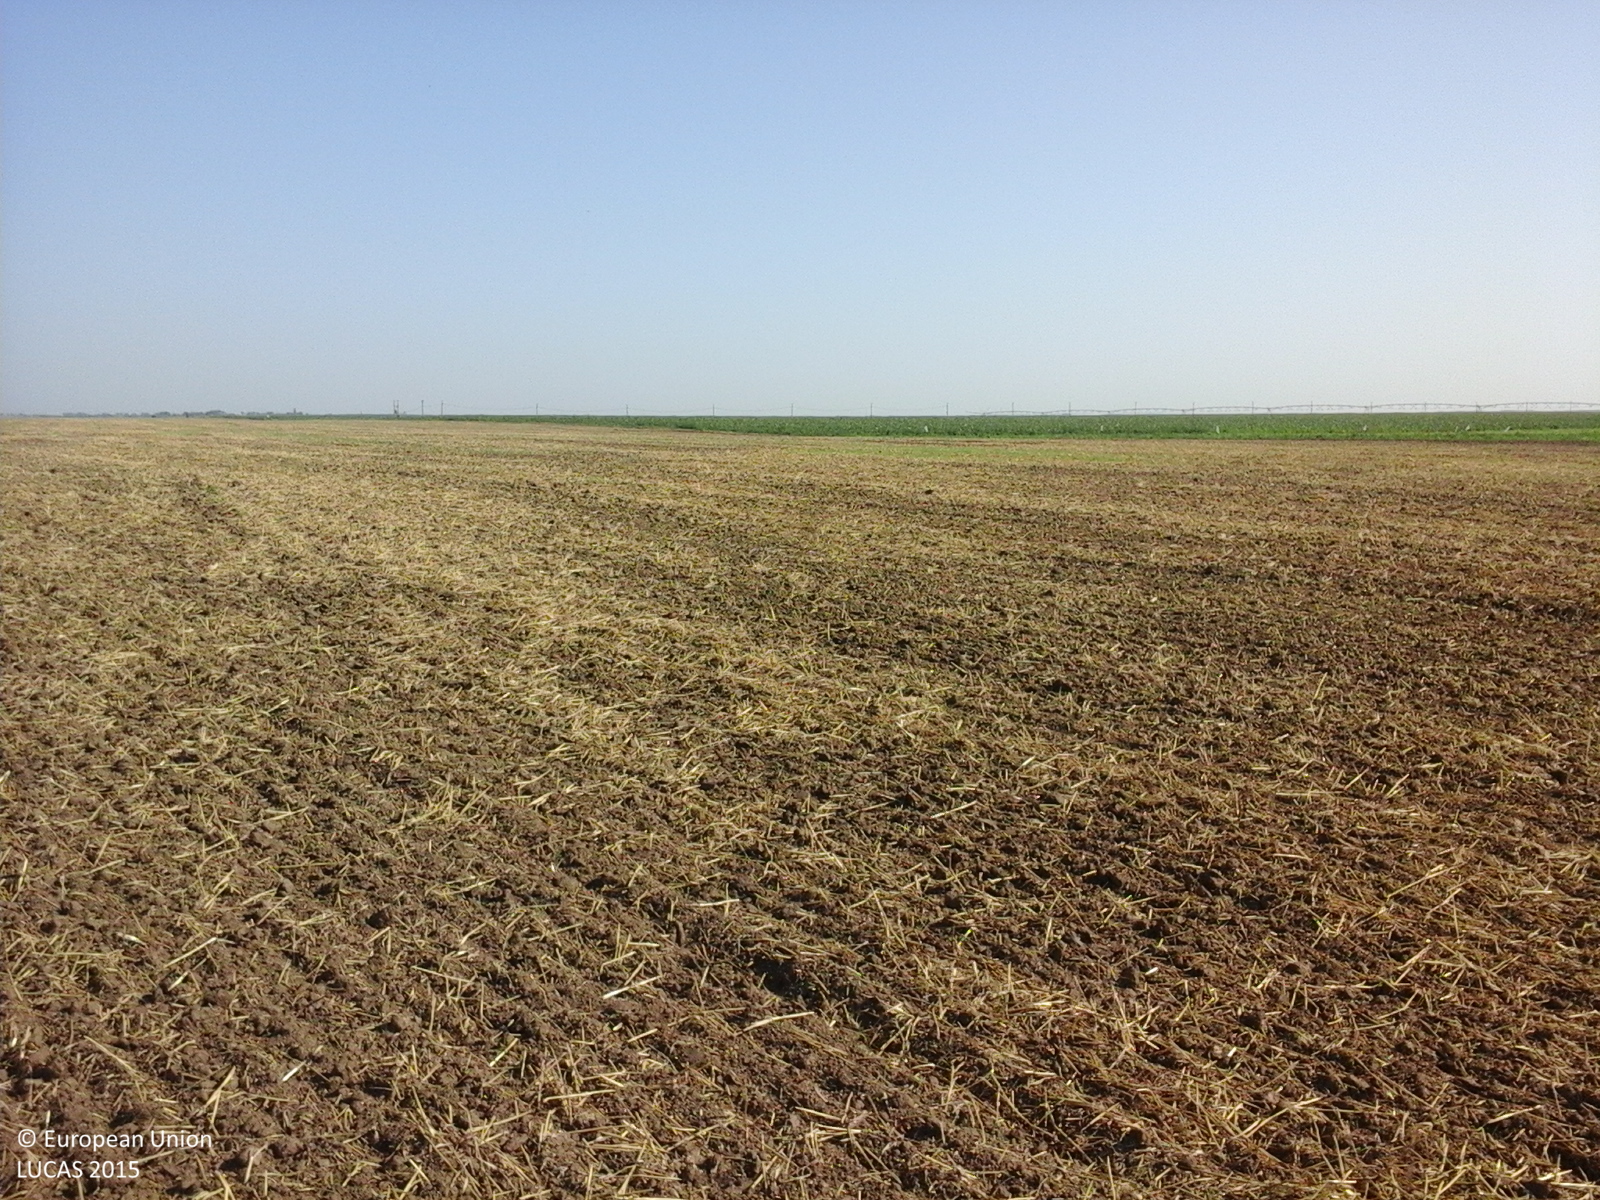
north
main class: Cropland
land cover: Durum wheat
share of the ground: < 10 %
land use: Agriculture (excluding fallow land and kitchen gardens)
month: July
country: RO
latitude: 44.3567
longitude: 27.5184
